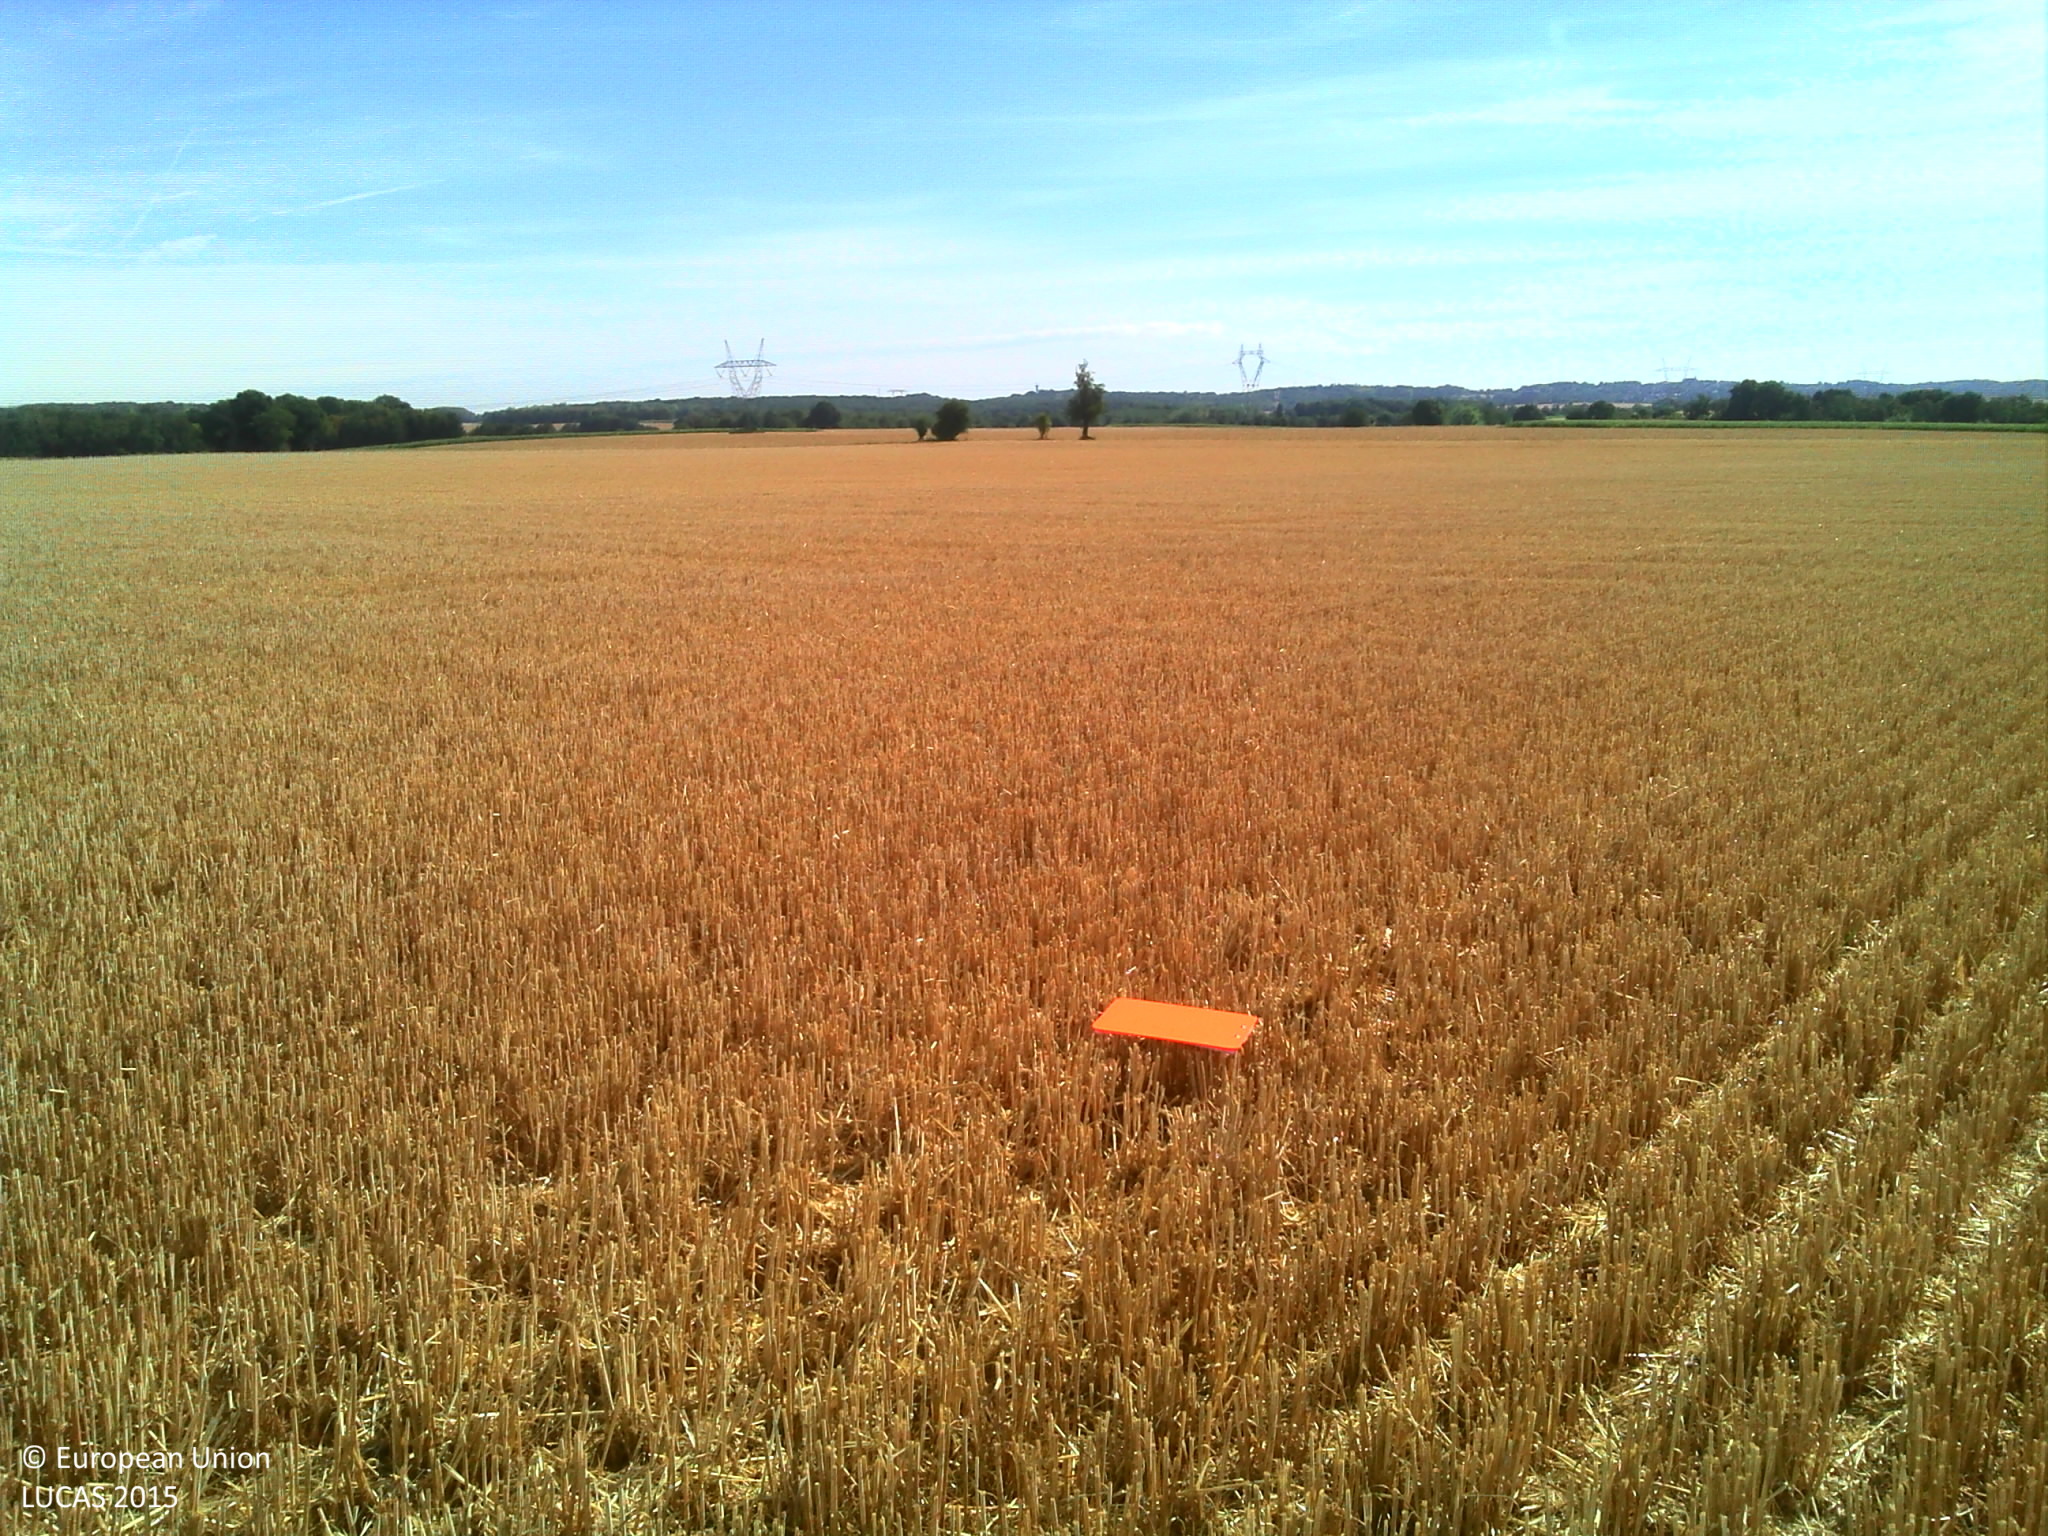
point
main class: Cropland
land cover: Common wheat
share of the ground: > 75 %
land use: Agriculture (excluding fallow land and kitchen gardens)
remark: Harvested field
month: August
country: FR
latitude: 49.0398
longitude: 2.5882
